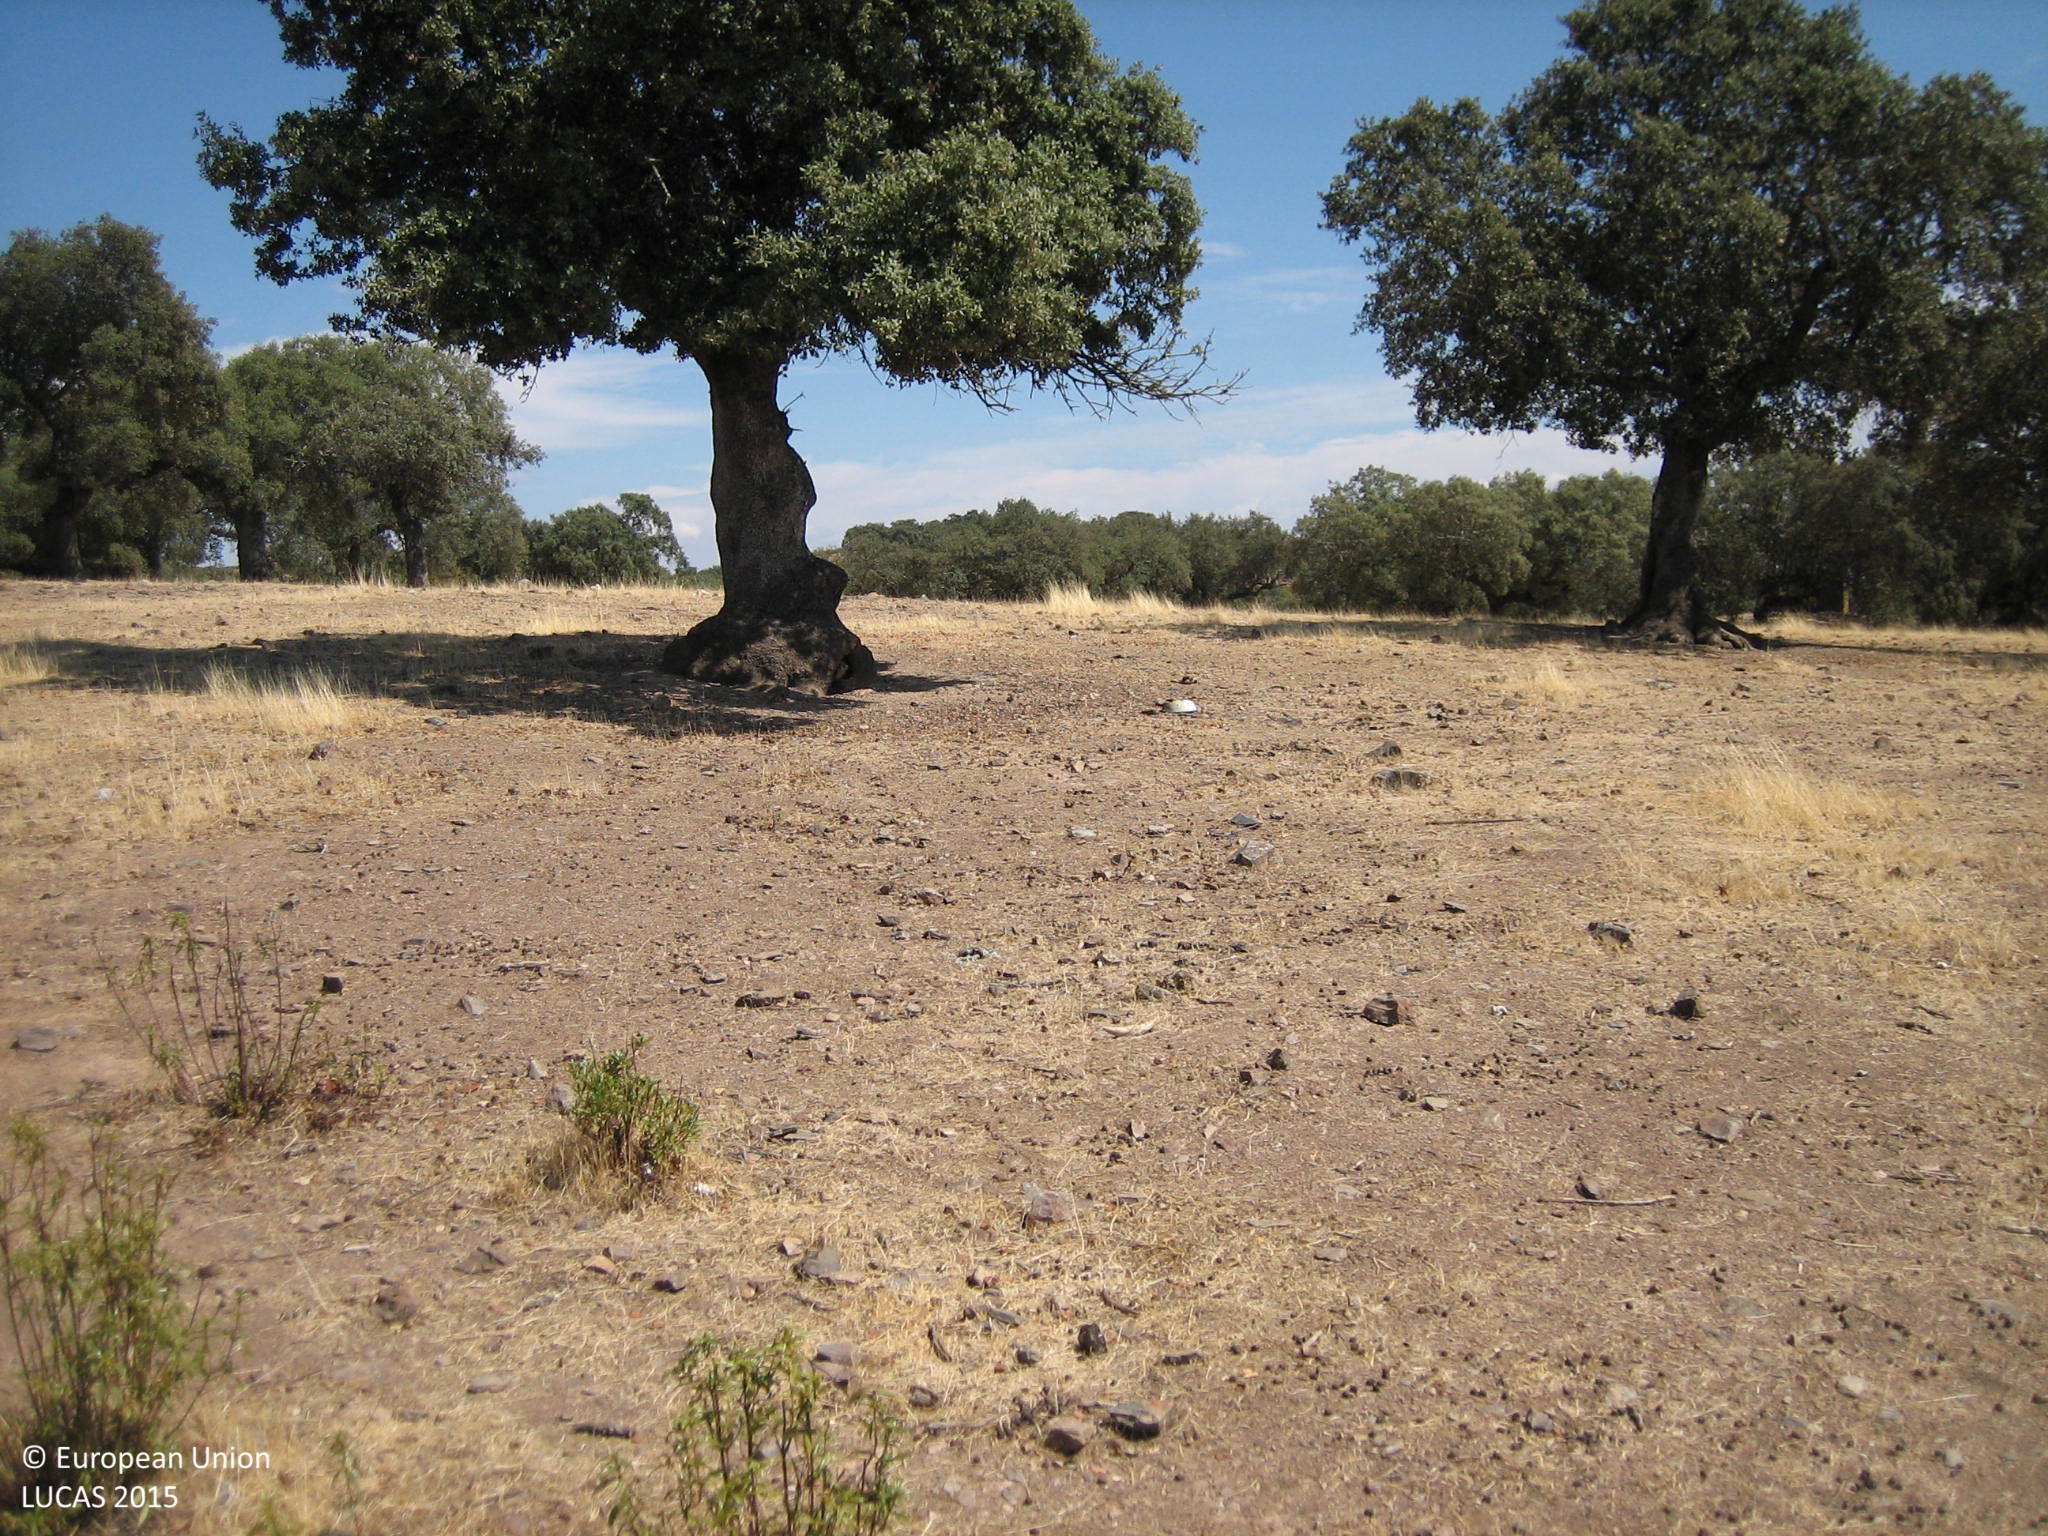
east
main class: Woodland
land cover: Broadleaved woodland
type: broadleaved evergreen forest
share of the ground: 10 - 25 %
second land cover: Grassland without tree/shrub cover
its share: 50 - 75 %
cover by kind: herbaceous plants 50 %, unconsolidated bare surface 25 %, broadleaved forest trees 20 %, shrubs 5 %
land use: Forestry
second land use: Agriculture (excluding fallow land and kitchen gardens)
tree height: > 5 m
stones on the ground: < 10 %
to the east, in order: Broadleaved woodland; Grassland without tree/shrub cover; Grassland with sparse tree/shrub cover; Tracks; Grassland without tree/shrub cover
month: September
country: ES
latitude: 38.2023
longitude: -7.0861
